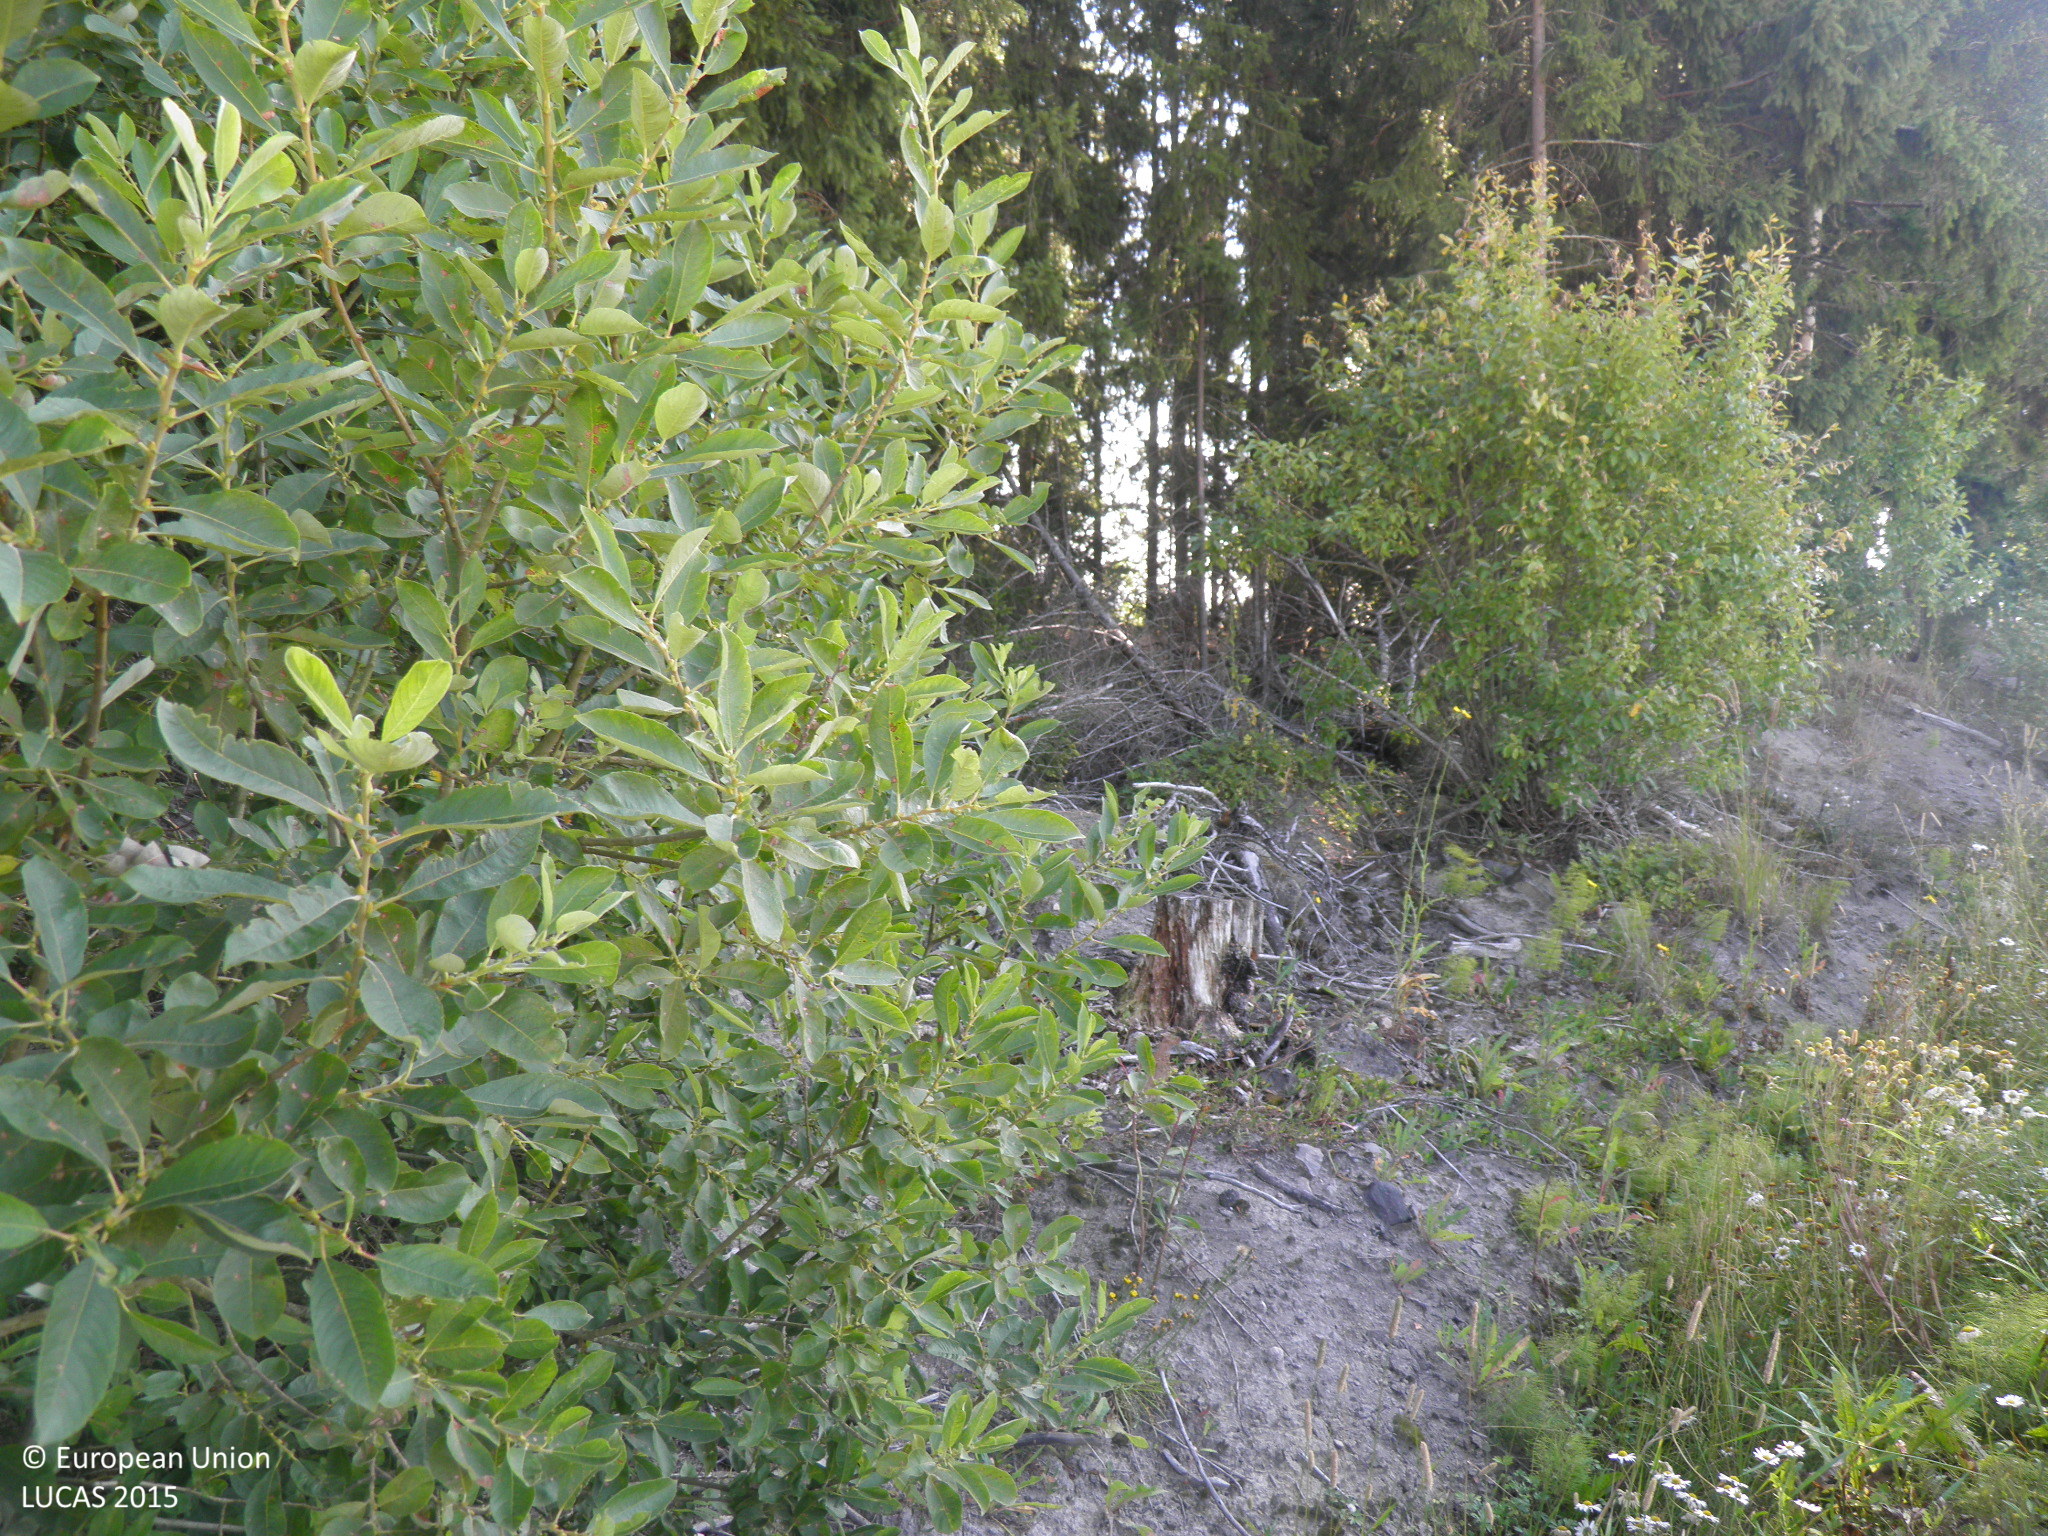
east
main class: Cropland
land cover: Common wheat
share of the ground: > 75 %
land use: Agriculture (excluding fallow land and kitchen gardens)
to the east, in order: Common wheat; Electric lines; Common wheat
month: August
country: FI
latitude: 60.7276
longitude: 23.0021
